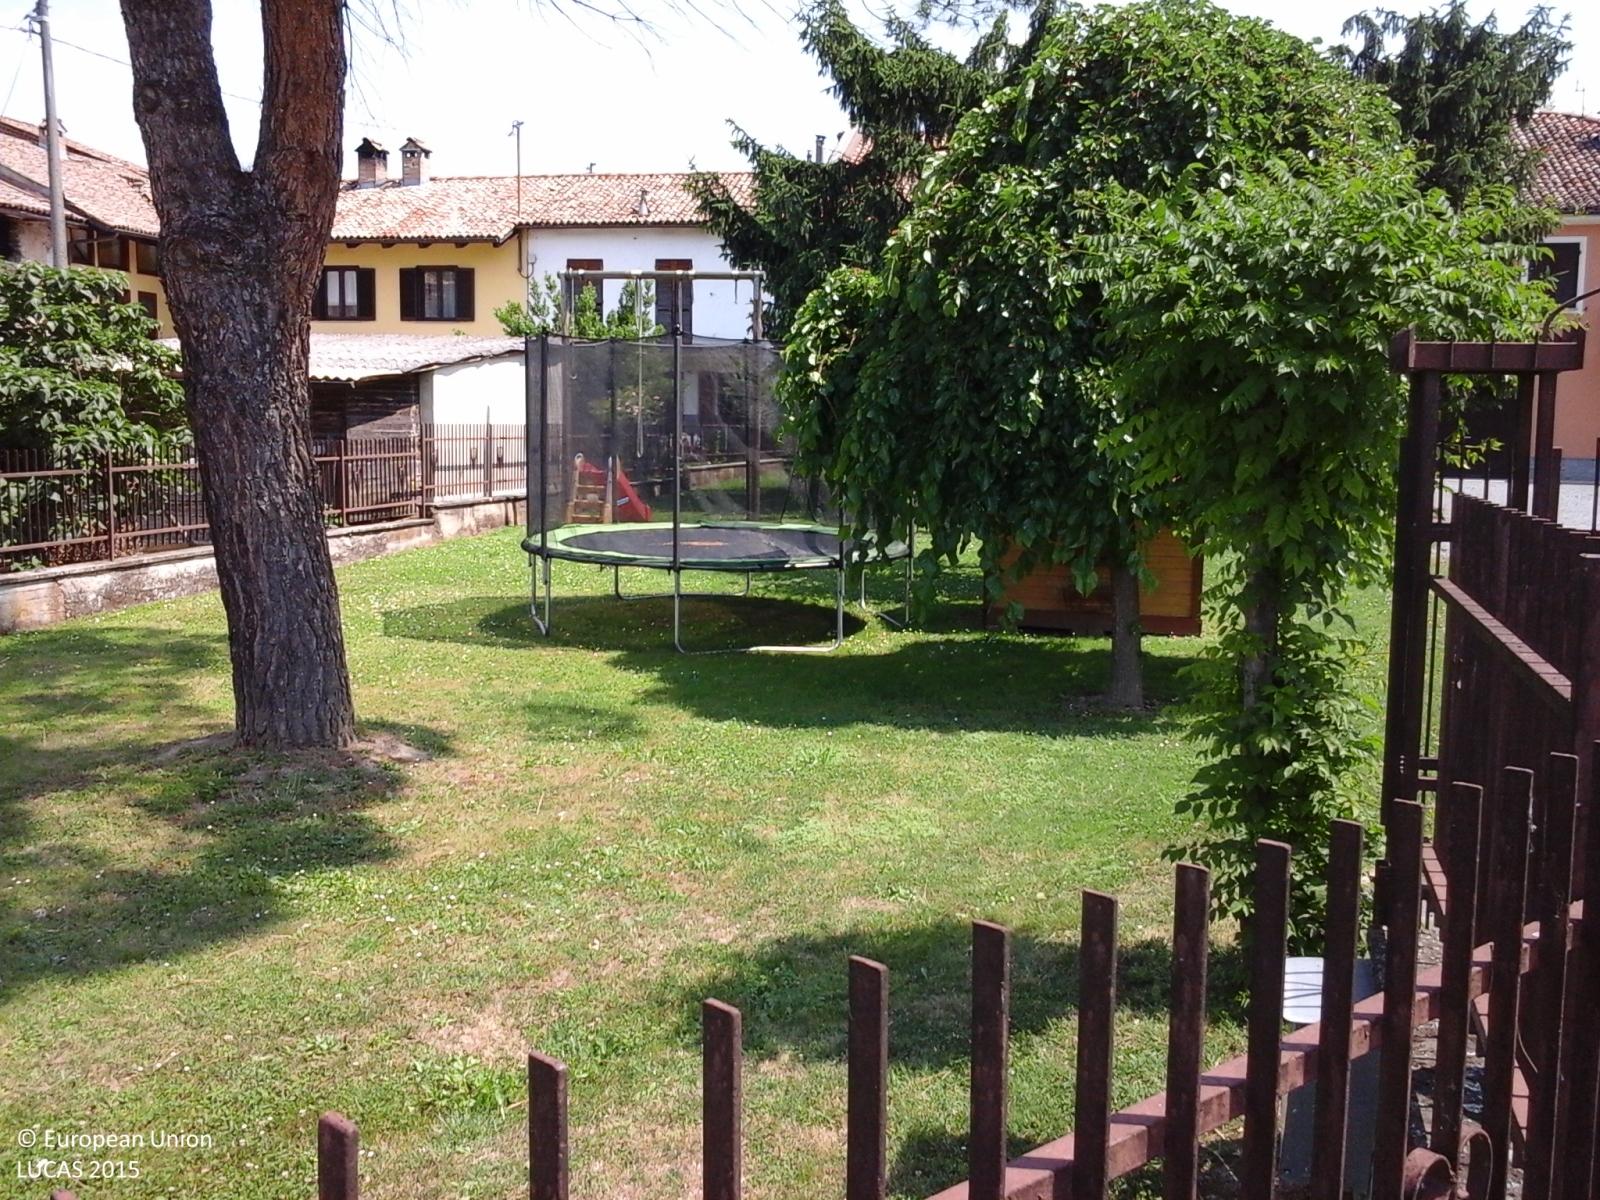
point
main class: Woodland
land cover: Other mixed woodland
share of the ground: 50 - 75 %
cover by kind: coniferous forest trees 50 %, herbaceous plants 30 %, broadleaved forest trees 20 %
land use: Residential
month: May
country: IT
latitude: 44.7338
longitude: 8.3239
